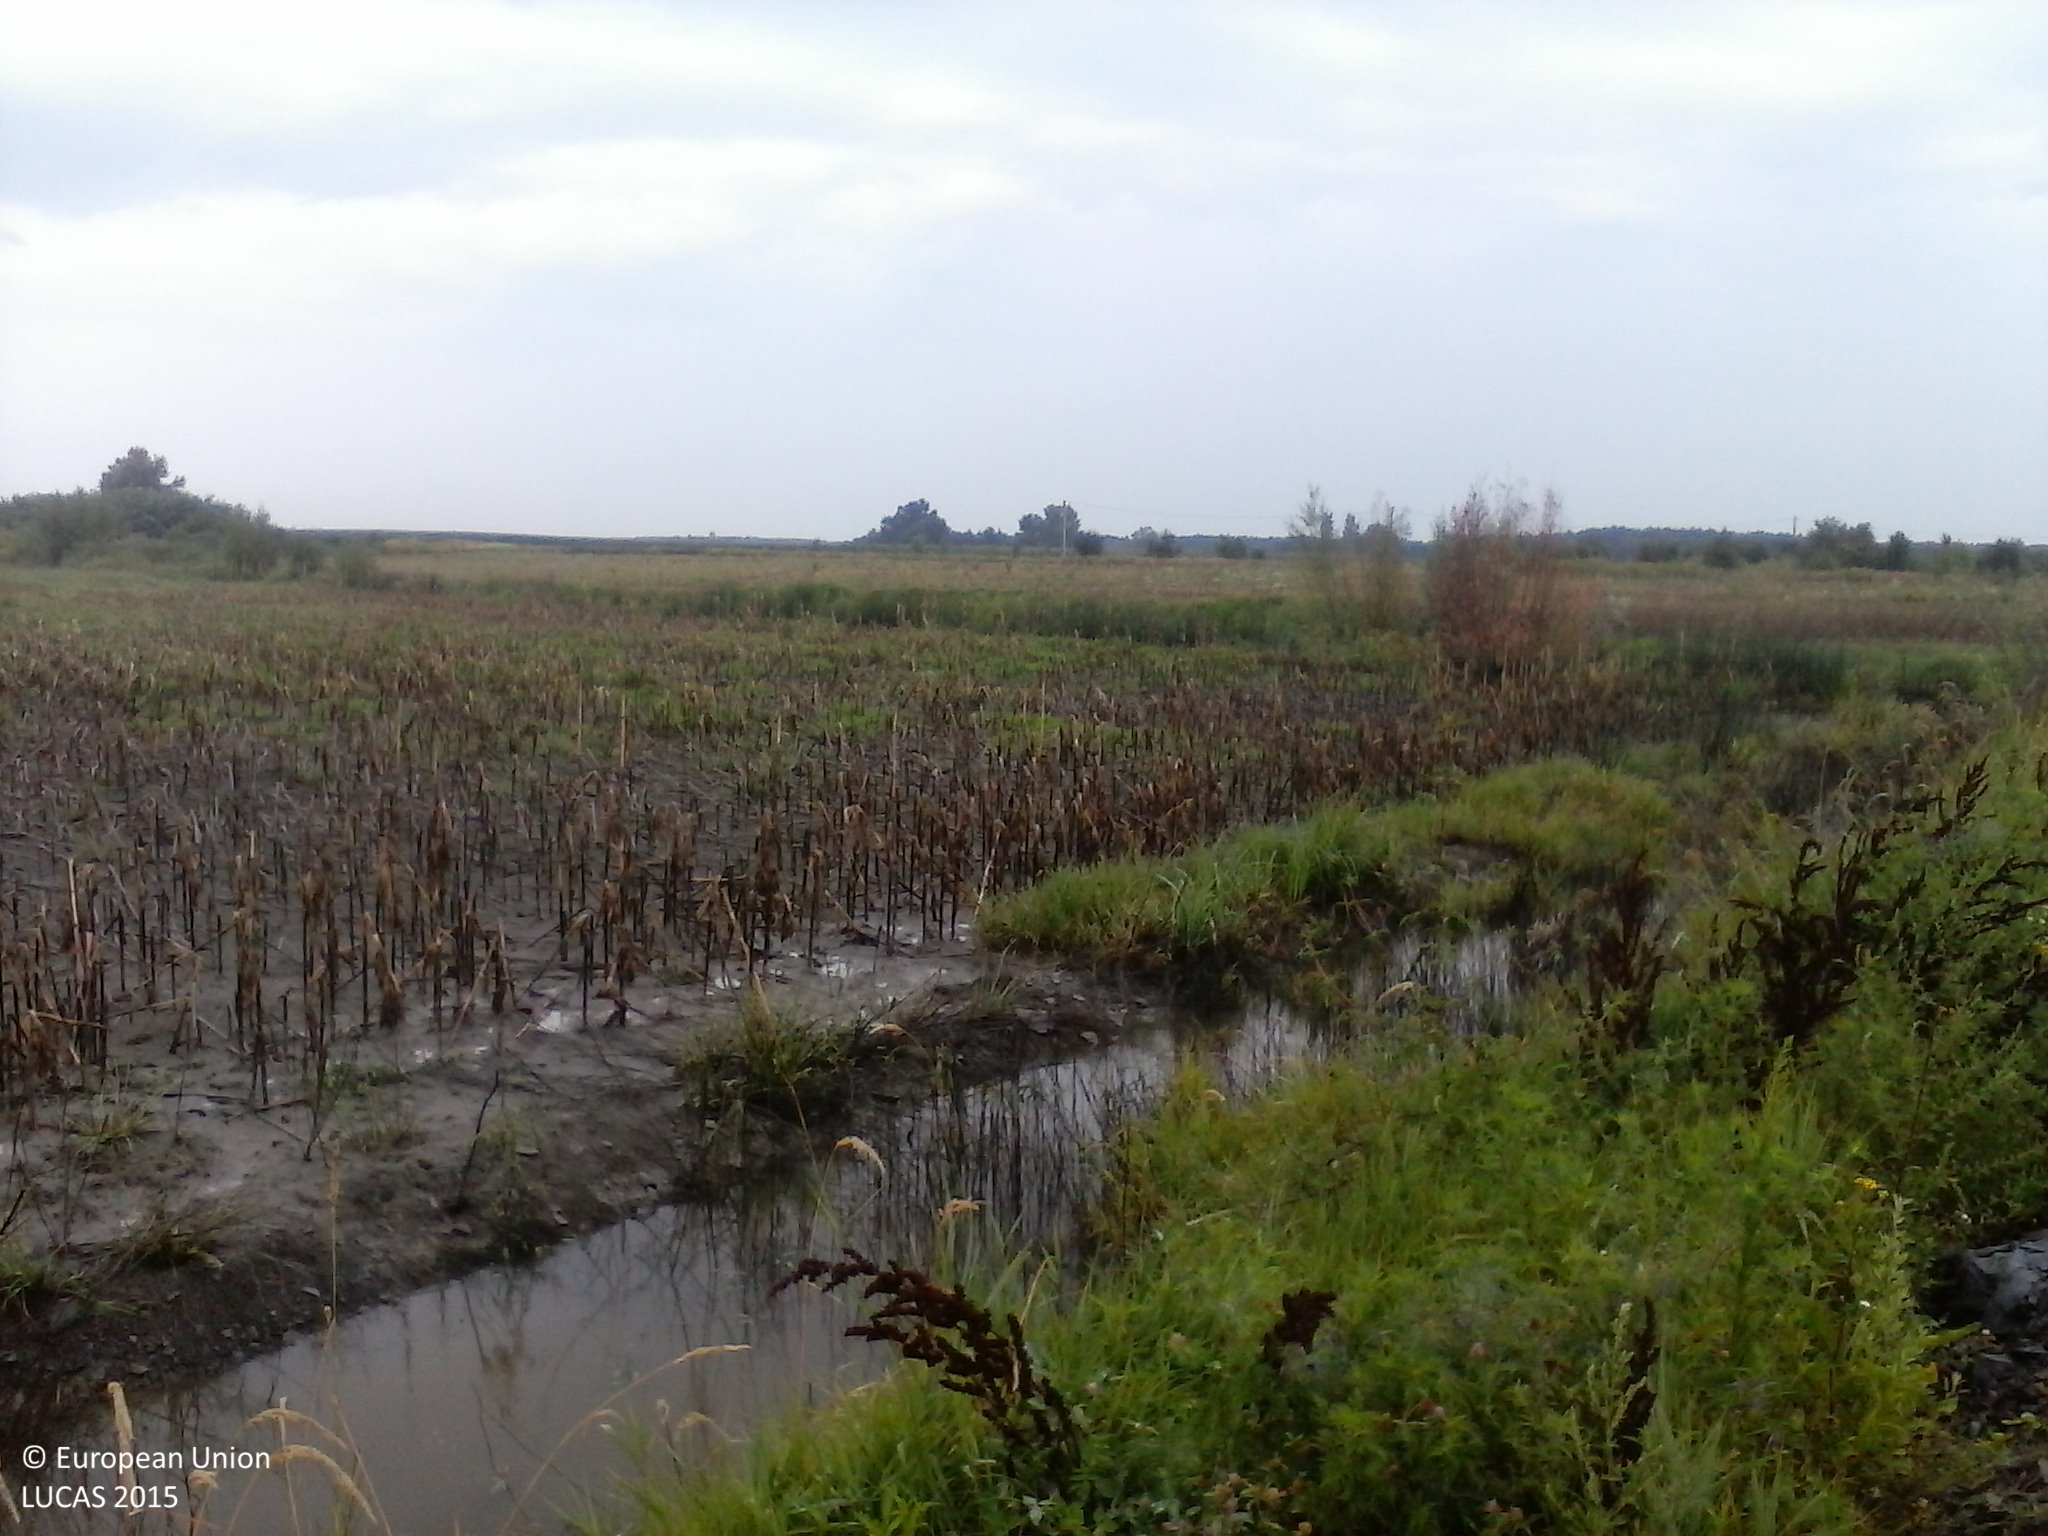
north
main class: Cropland
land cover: Maize
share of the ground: 50 - 75 %
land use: Agriculture (excluding fallow land and kitchen gardens)
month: July
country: HU
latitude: 46.0254
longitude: 17.6128
